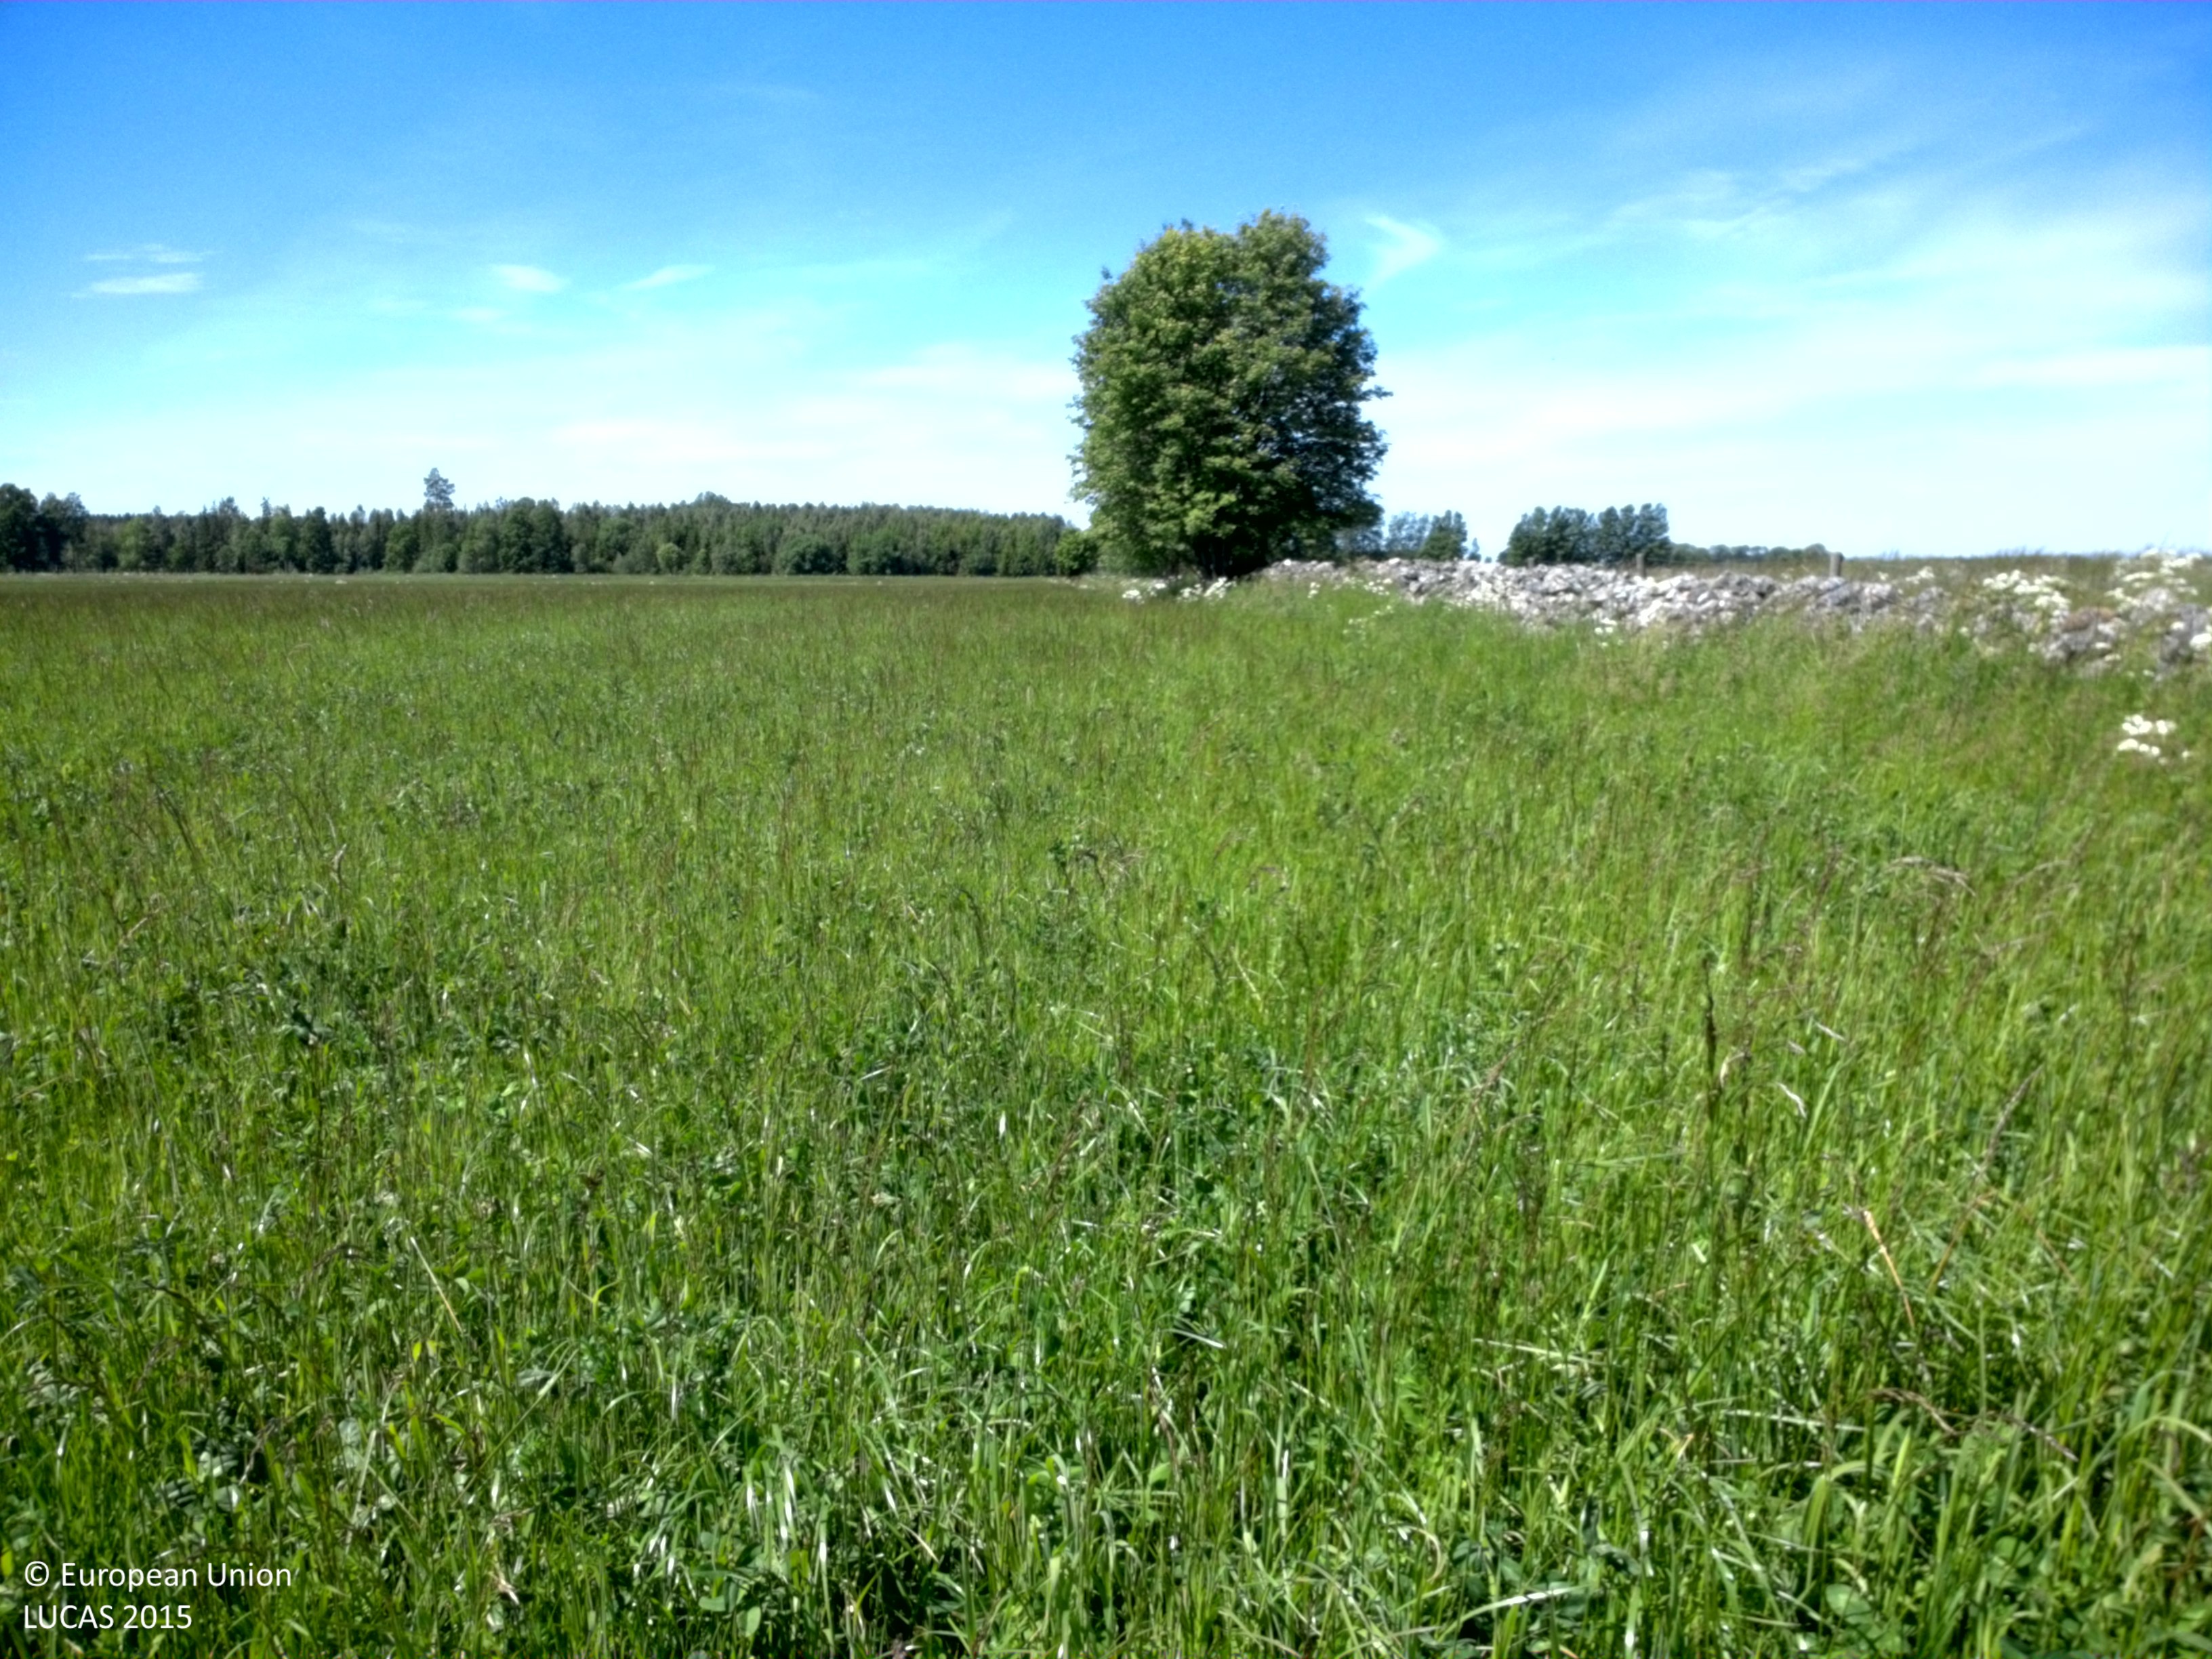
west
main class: Cropland
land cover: Other leguminous and mixtures for fodder
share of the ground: > 75 %
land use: Agriculture (excluding fallow land and kitchen gardens)
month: June
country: SE
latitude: 58.4898
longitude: 15.3977
